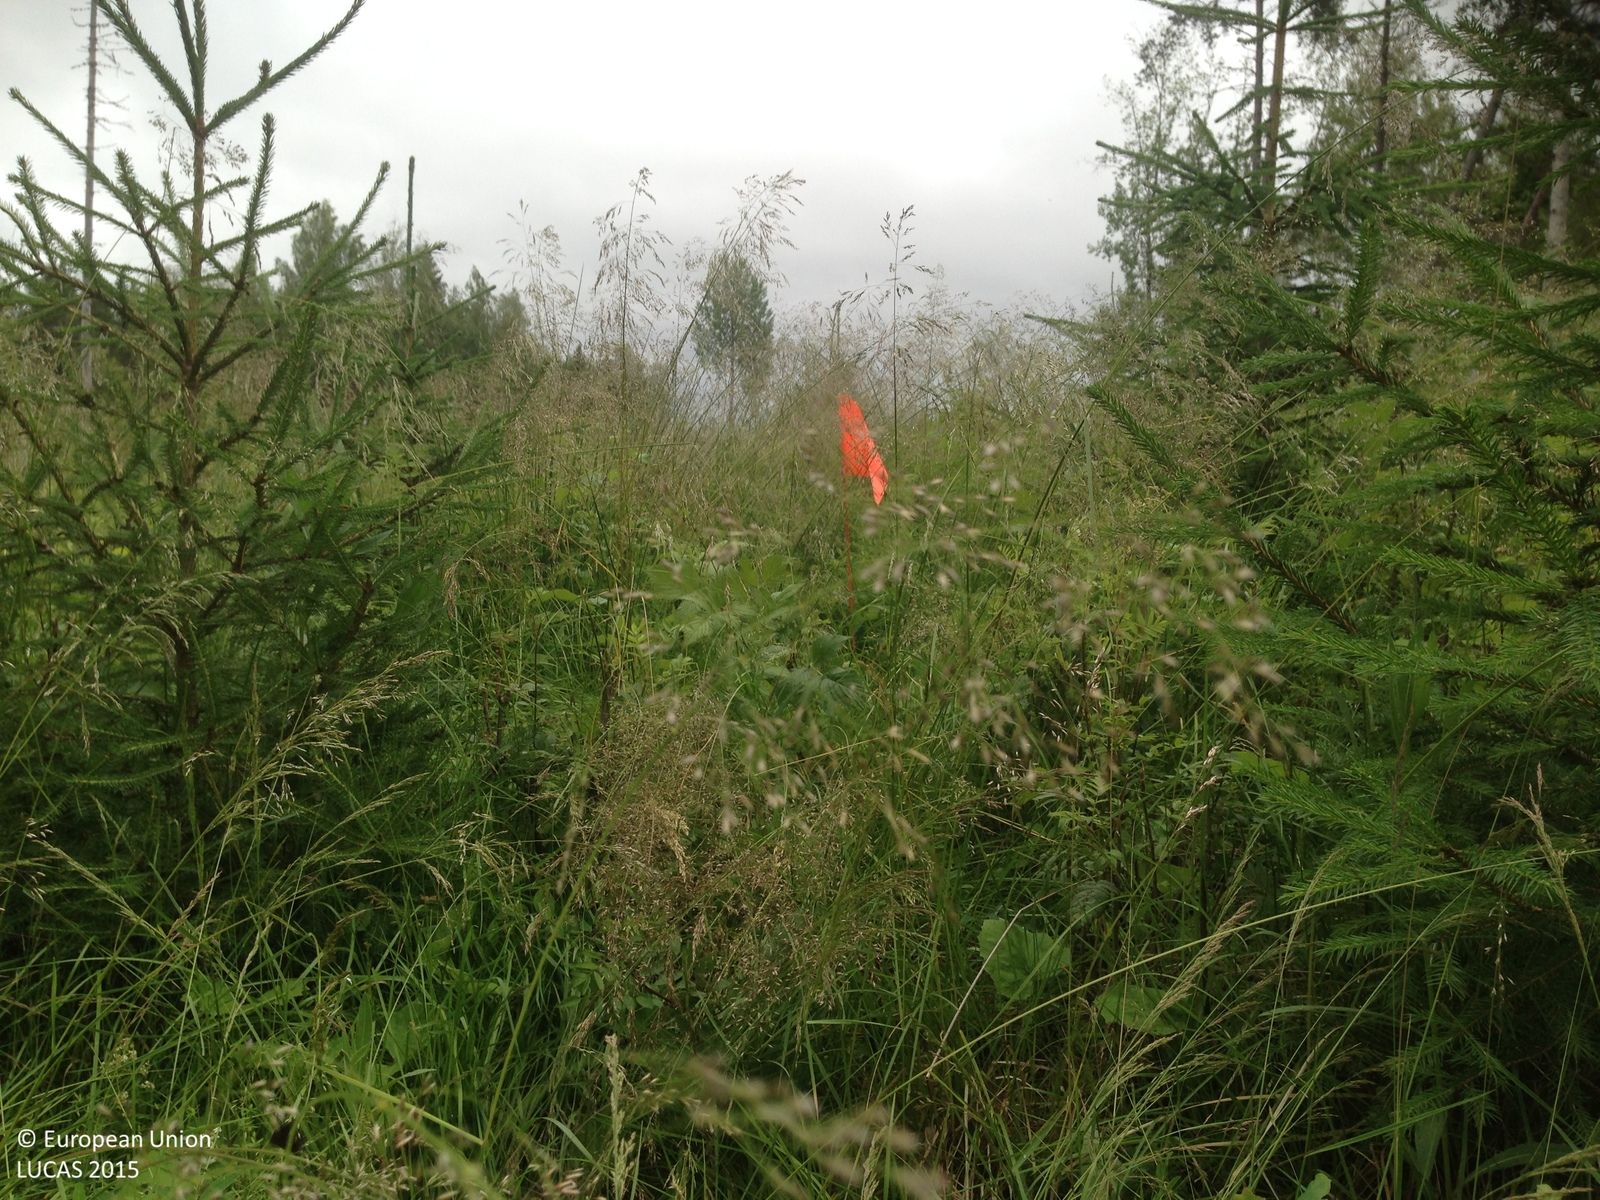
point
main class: Woodland
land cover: Spruce dominated coniferous woodland
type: boreal forest
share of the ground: 25 - 50 %
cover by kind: coniferous forest trees 40 %, herbaceous plants 25 %, lichens and mosses 25 %, broadleaved forest trees 10 %
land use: Forestry
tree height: < 5 m
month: July
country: SE
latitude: 59.8814
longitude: 16.9778
